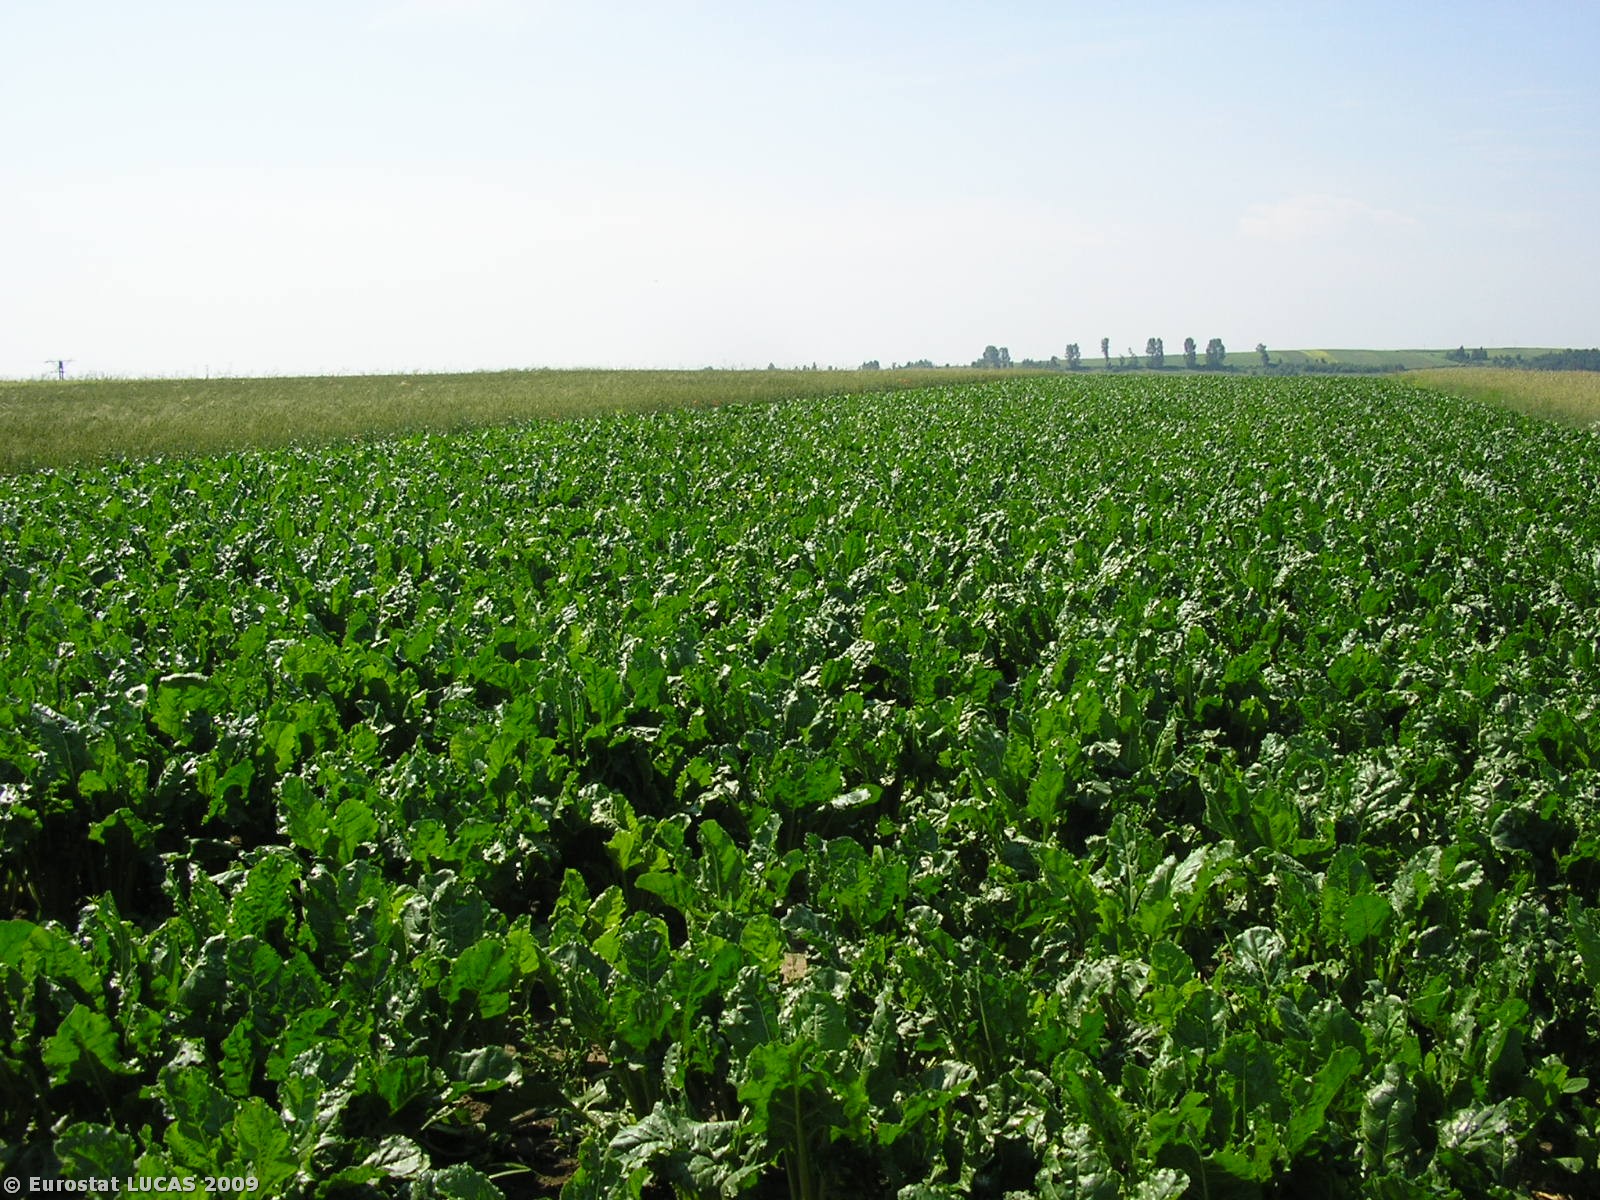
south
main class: Cropland
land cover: Barley
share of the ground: > 75 %
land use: Agriculture (excluding fallow land and kitchen gardens)
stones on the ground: < 10 %
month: June
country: PL
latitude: 50.3705
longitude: 20.2851
